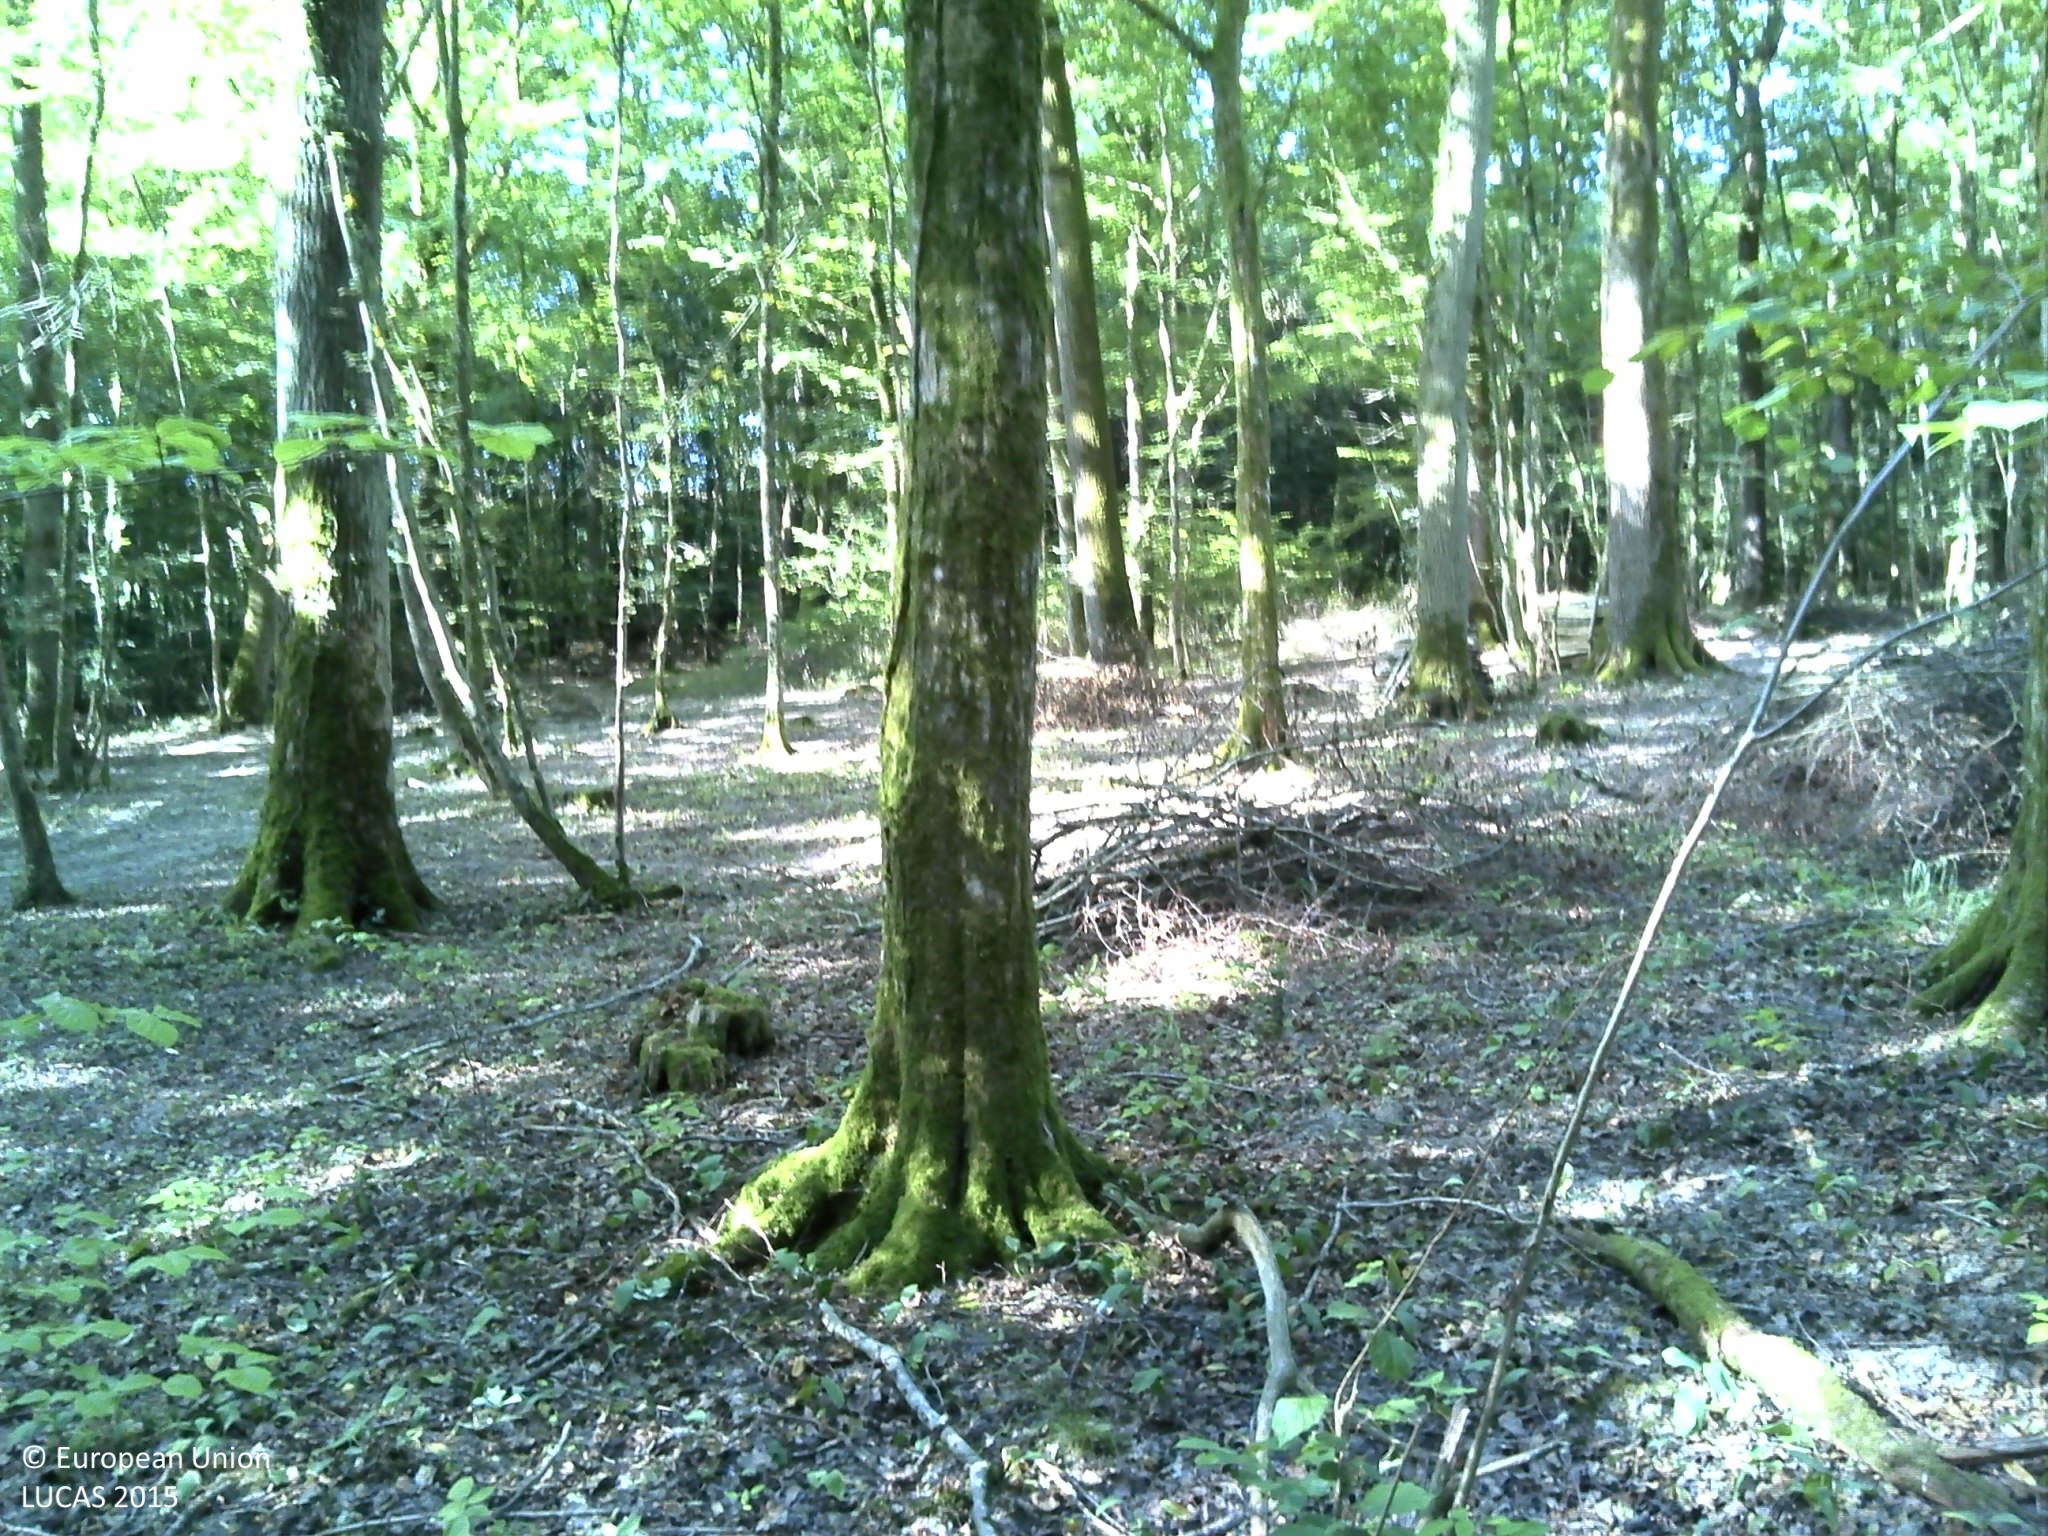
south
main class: Woodland
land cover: Broadleaved woodland
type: beech forest
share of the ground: > 75 %
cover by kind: broadleaved forest trees 100 %
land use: Forestry
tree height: > 5 m
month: July
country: FR
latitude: 48.2620
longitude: 6.0803
